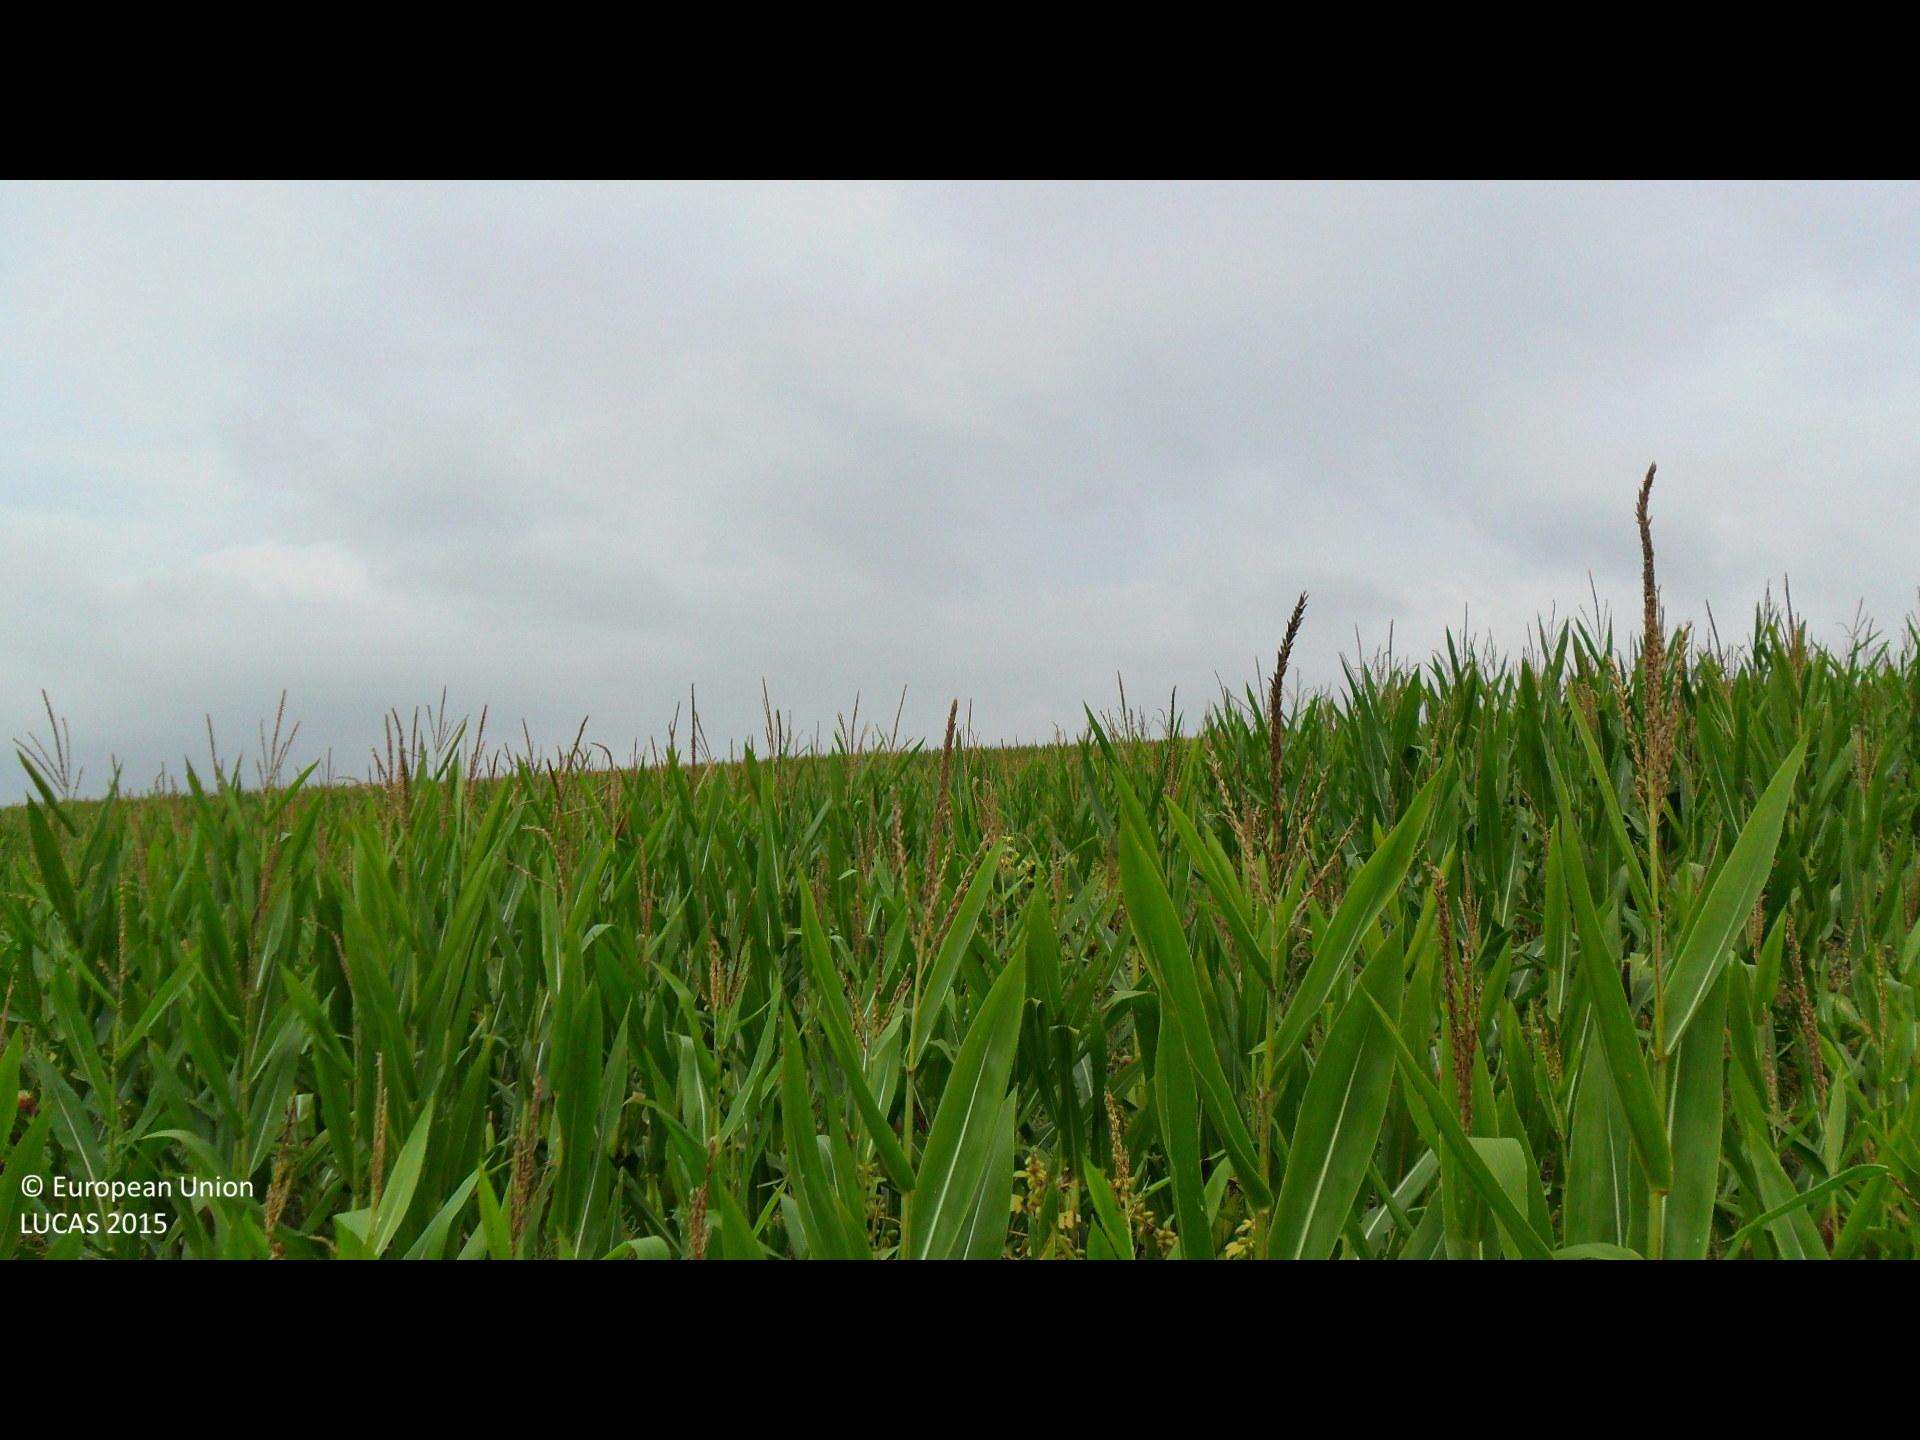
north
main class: Cropland
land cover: Maize
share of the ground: > 75 %
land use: Agriculture (excluding fallow land and kitchen gardens)
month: September
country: BG
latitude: 43.0805
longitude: 26.3460
